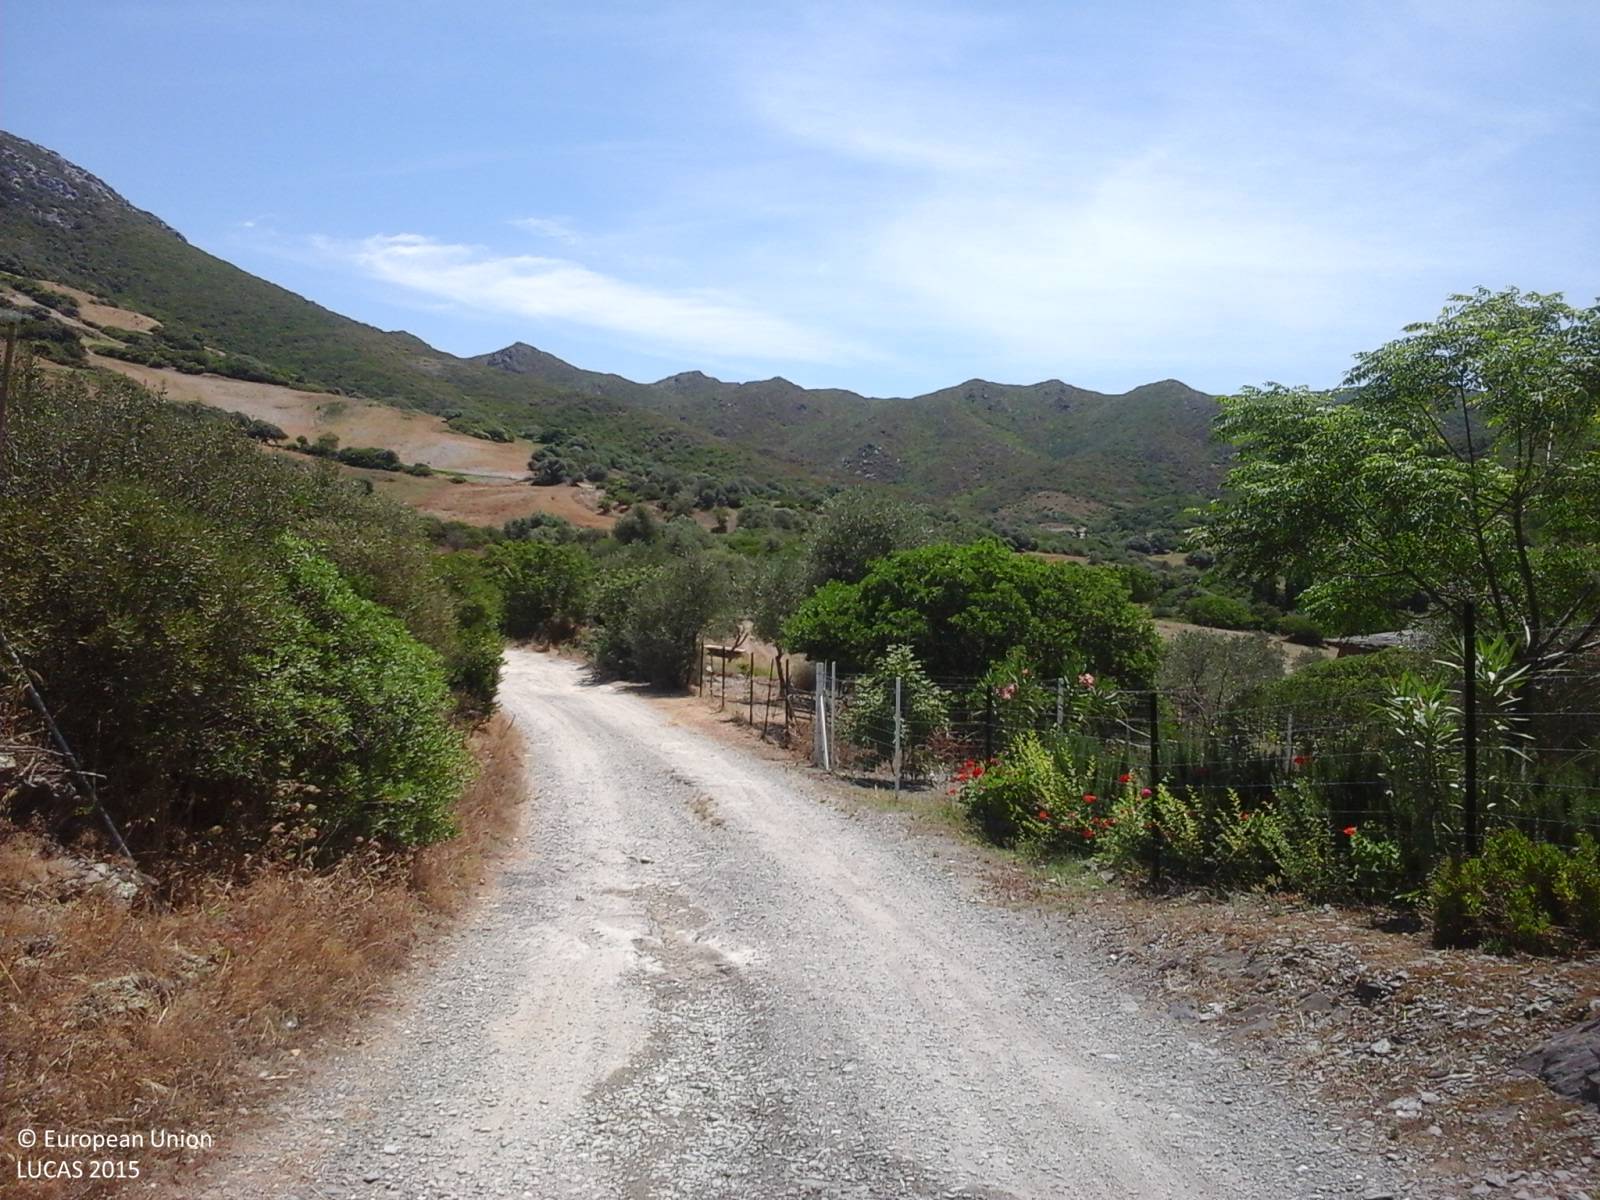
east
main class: Woodland
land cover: Other mixed woodland
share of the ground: 25 - 50 %
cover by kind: herbaceous plants 50 %, broadleaved forest trees 25 %, coniferous forest trees 10 %, unconsolidated bare surface 10 %, shrubs 5 %
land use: Residential
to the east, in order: Other mixed woodland; Shrubland with sparse tree cover; Grassland without tree/shrub cover; Abandoned hedges; Shrubland with sparse tree cover; Abandoned hedges; Fences; Paved roads, cycling and walking lanes; Fences; Broadleaved woodland; Oats; Fences; Abandoned hedges; Grassland without tree/shrub cover
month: June
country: IT
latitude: 39.2242
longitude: 8.5610
